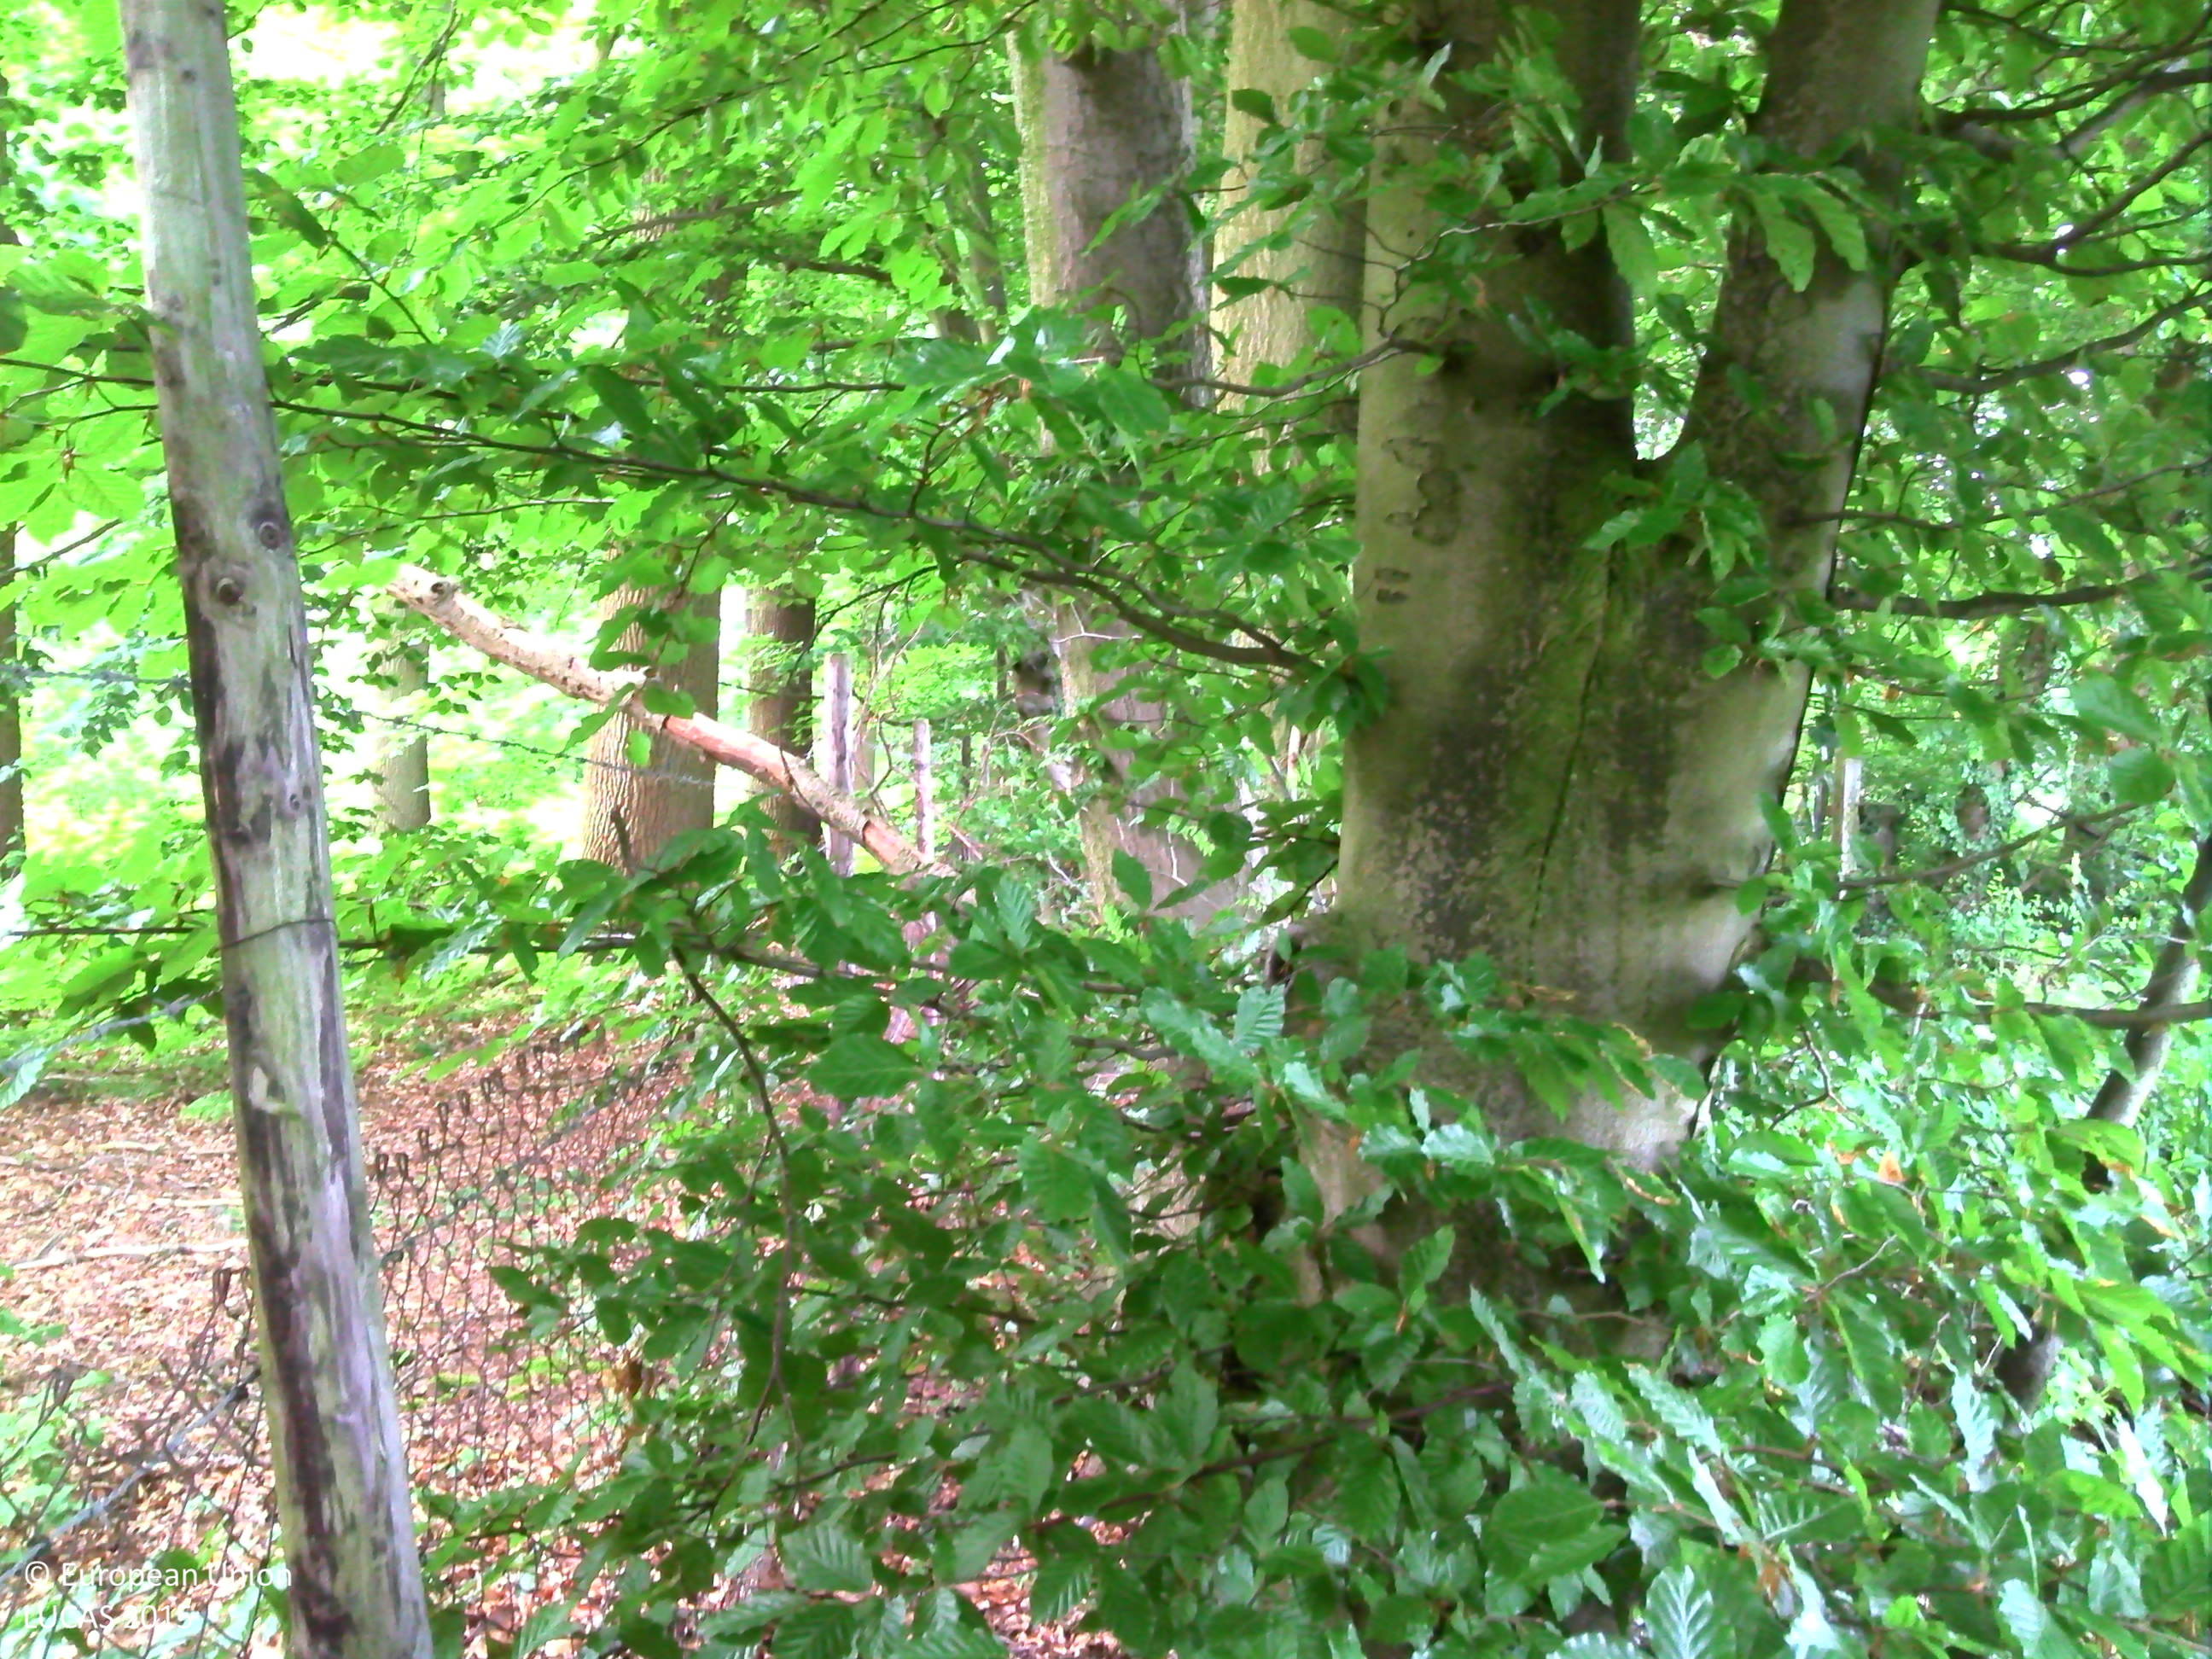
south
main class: Woodland
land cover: Broadleaved woodland
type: acidophilous oak and oak-birch forest
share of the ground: > 75 %
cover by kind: broadleaved forest trees 95 %, herbaceous plants 5 %
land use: Forestry
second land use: Amenities, museums, leisure
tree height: > 5 m
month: June
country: BE
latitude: 50.8897
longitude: 5.5486
